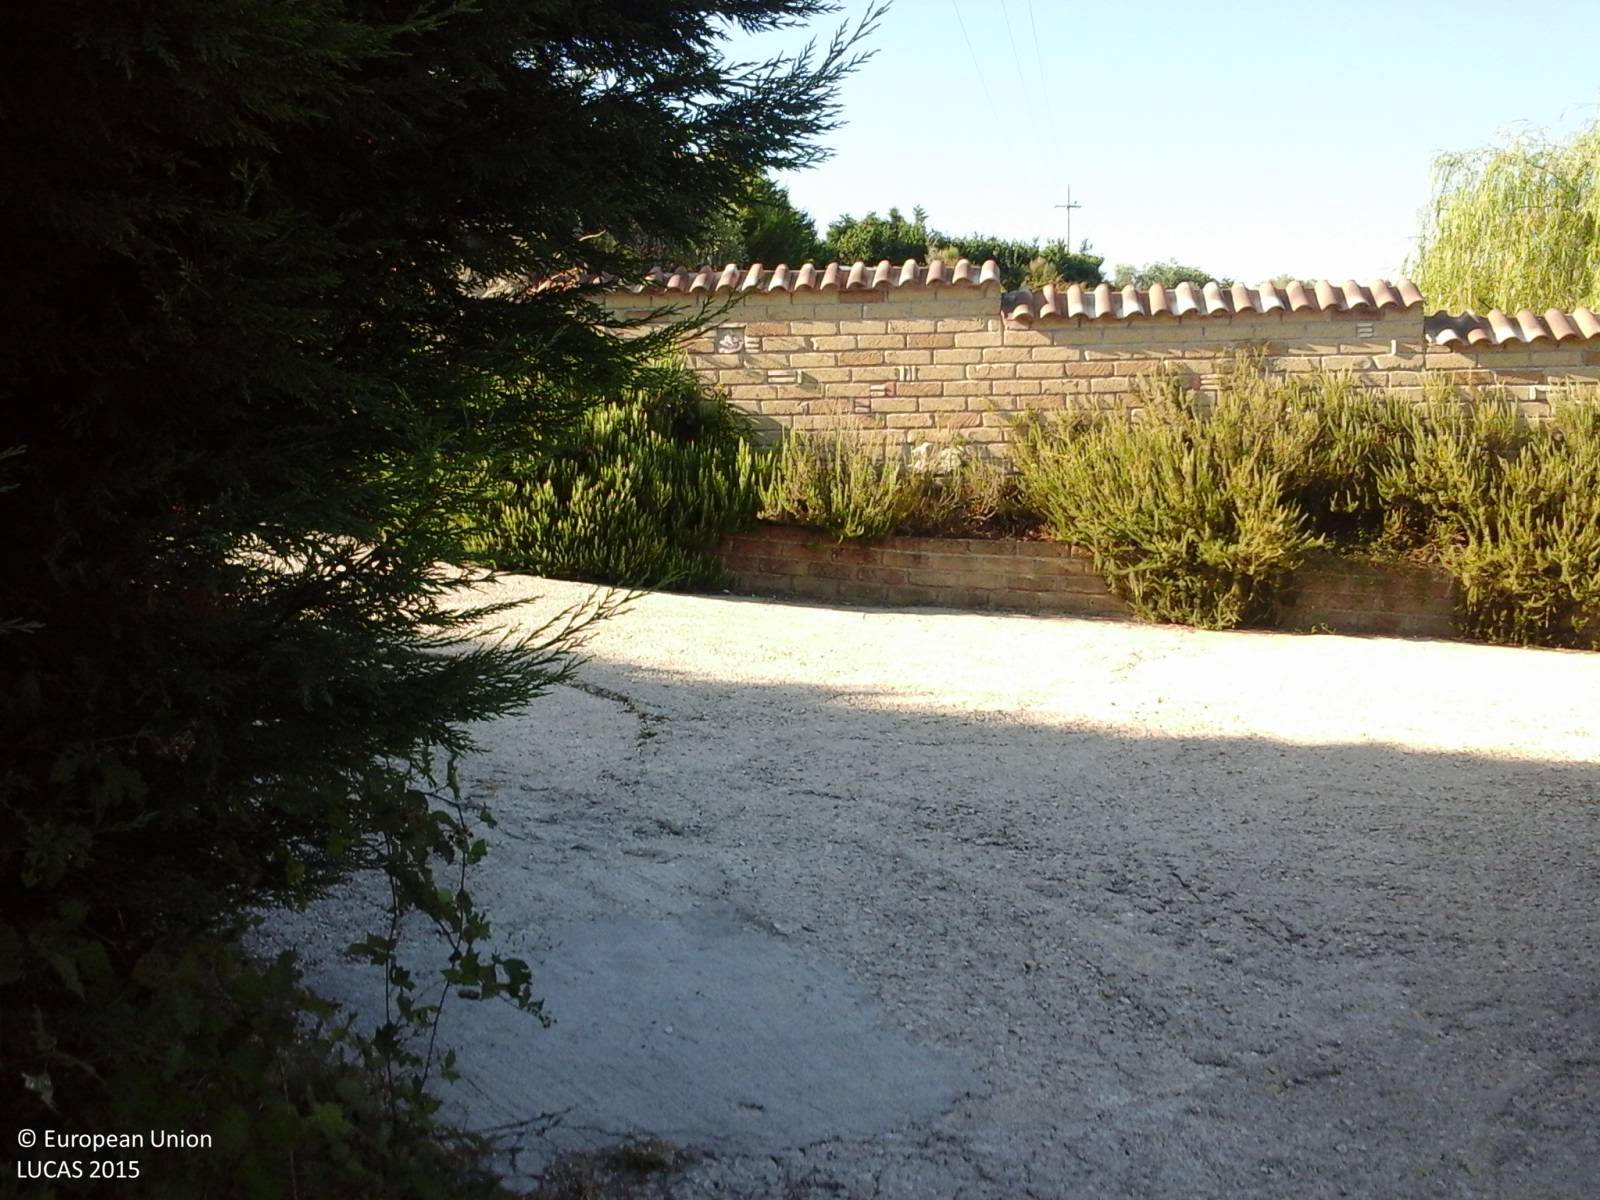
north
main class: Grassland
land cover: Grassland without tree/shrub cover
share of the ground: 50 - 75 %
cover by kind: herbaceous plants 100 %
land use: Residential
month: July
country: IT
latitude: 42.1202
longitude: 12.3743
